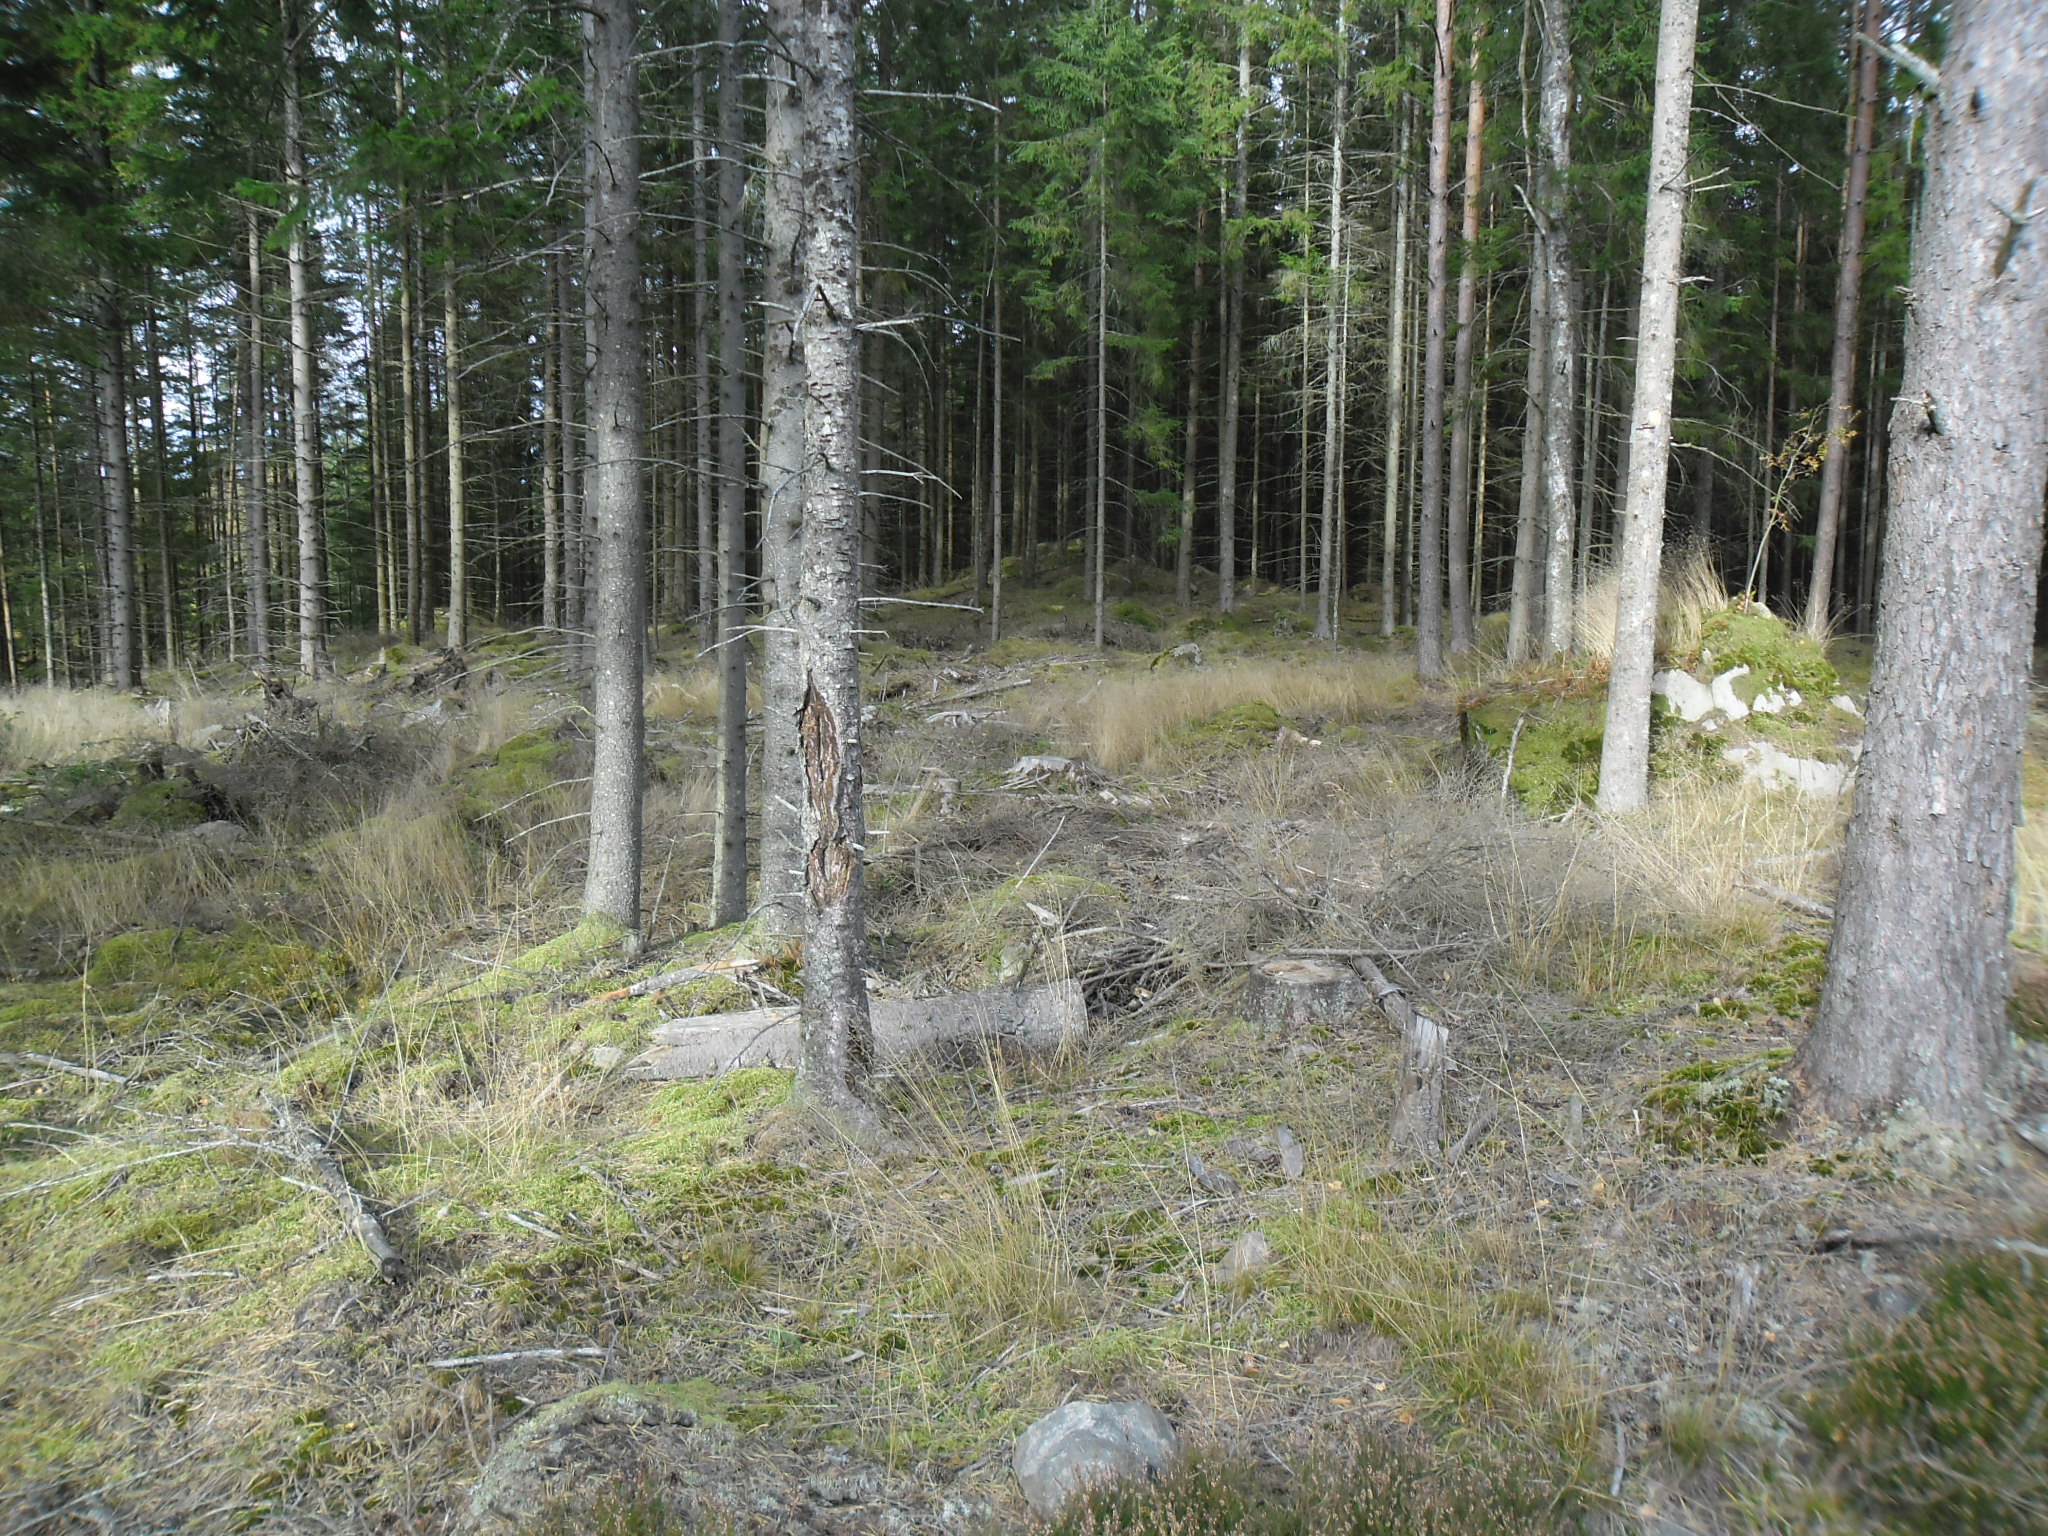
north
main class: Woodland
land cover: Spruce dominated coniferous woodland
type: boreal forest
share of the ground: > 75 %
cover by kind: coniferous forest trees 70 %, herbaceous plants 15 %, lichens and mosses 15 %
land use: Forestry
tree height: > 5 m
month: October
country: SE
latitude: 56.4193
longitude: 13.8067
